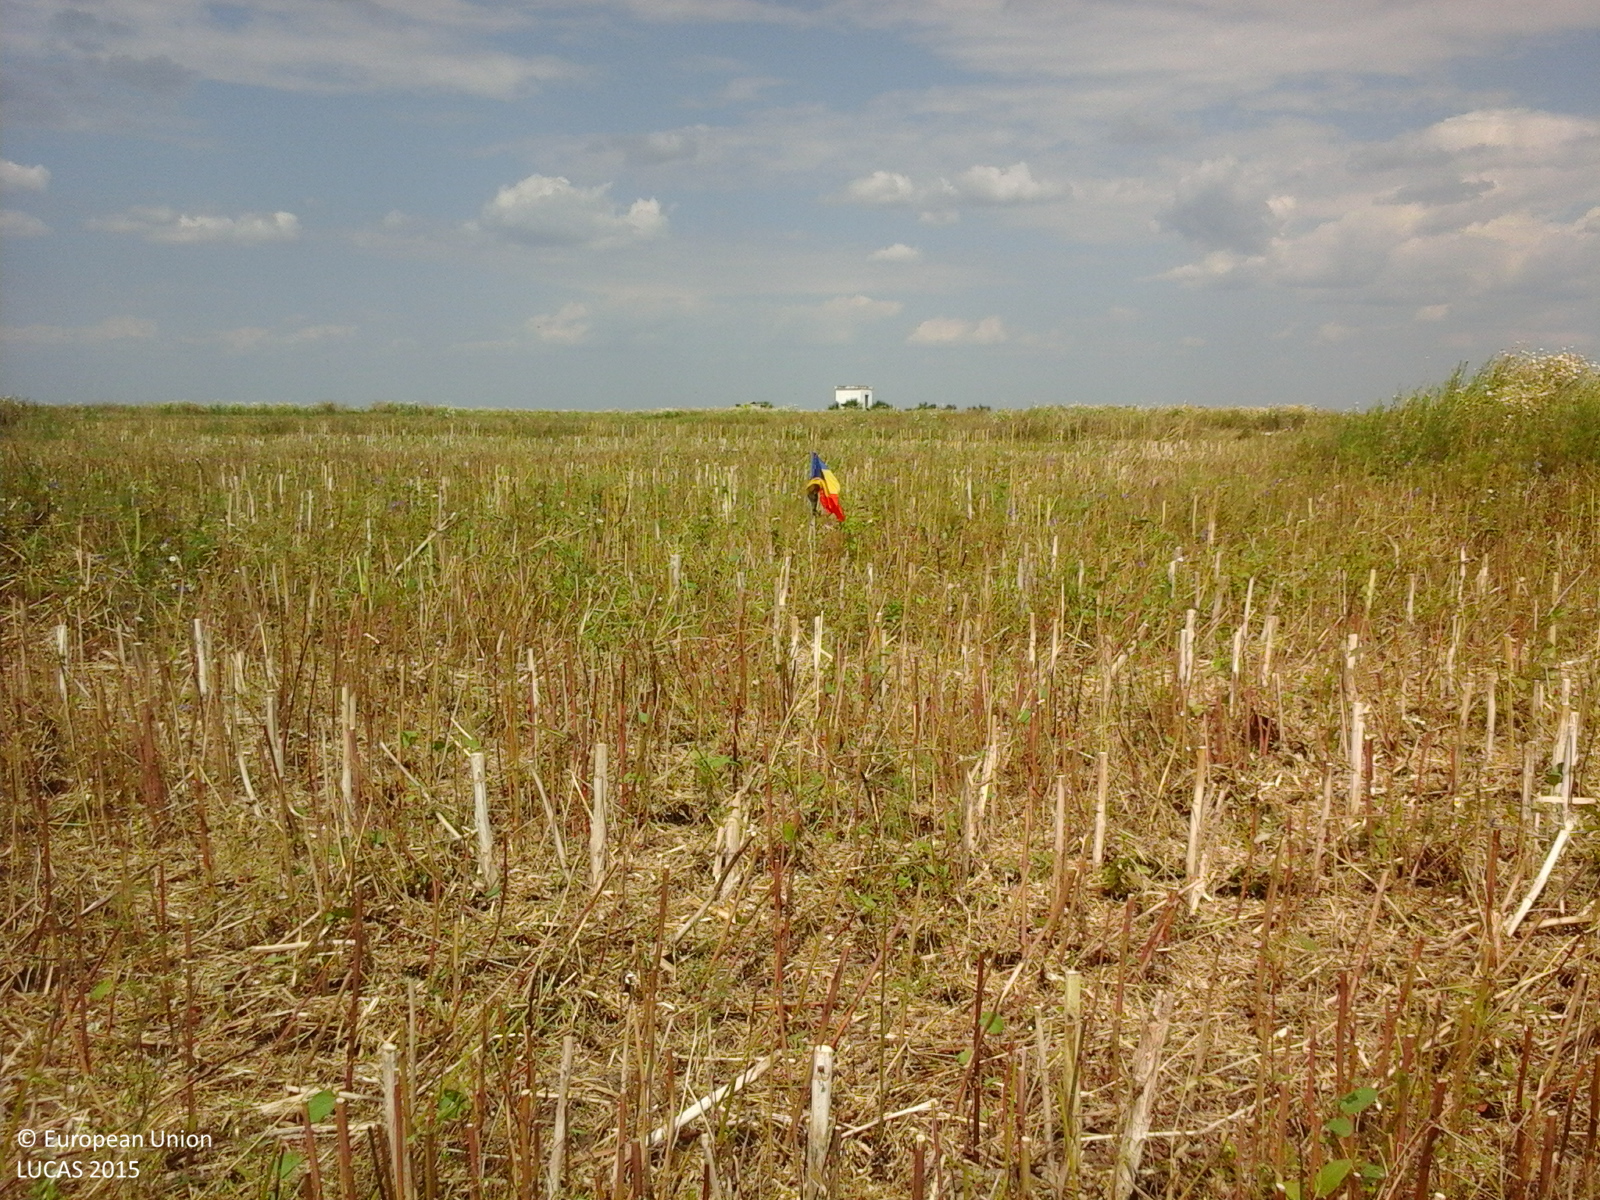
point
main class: Cropland
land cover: Rape and turnip rape
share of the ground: < 10 %
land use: Agriculture (excluding fallow land and kitchen gardens)
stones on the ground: 10 - 25 %
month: June
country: RO
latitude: 44.6120
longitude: 26.3043
